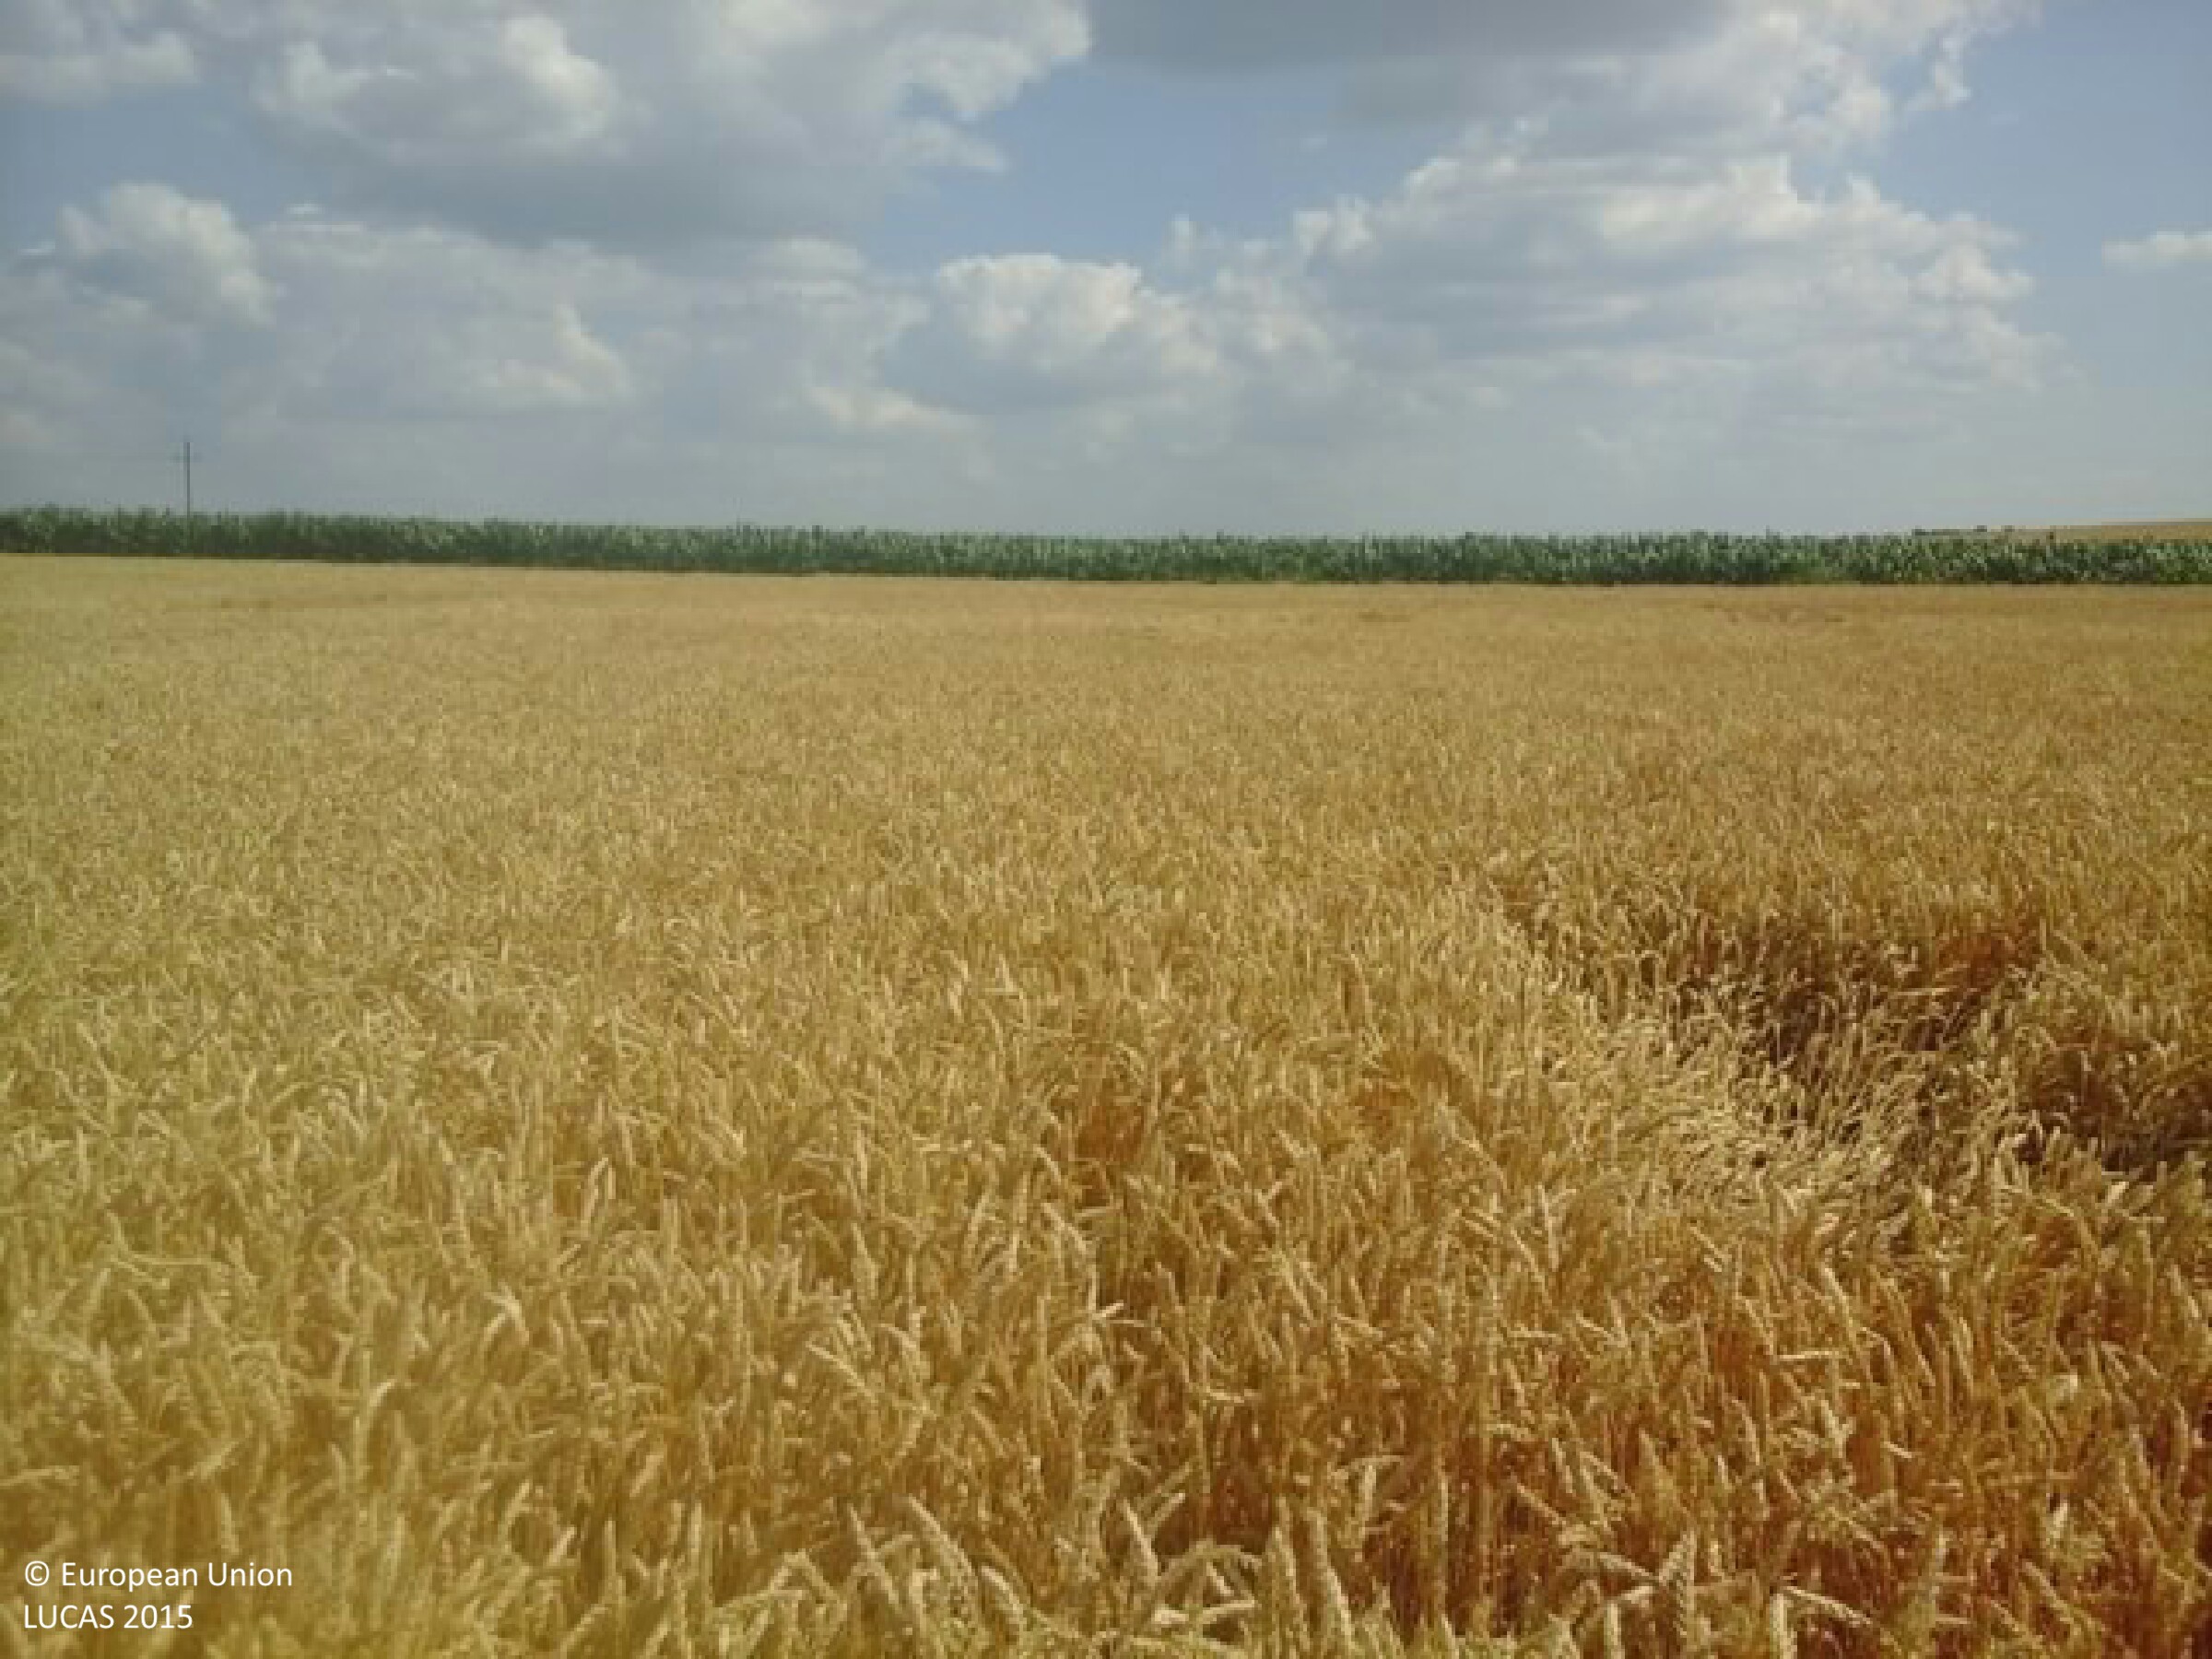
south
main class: Cropland
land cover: Common wheat
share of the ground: > 75 %
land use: Agriculture (excluding fallow land and kitchen gardens)
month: June
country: HU
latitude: 46.0778
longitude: 19.0247
